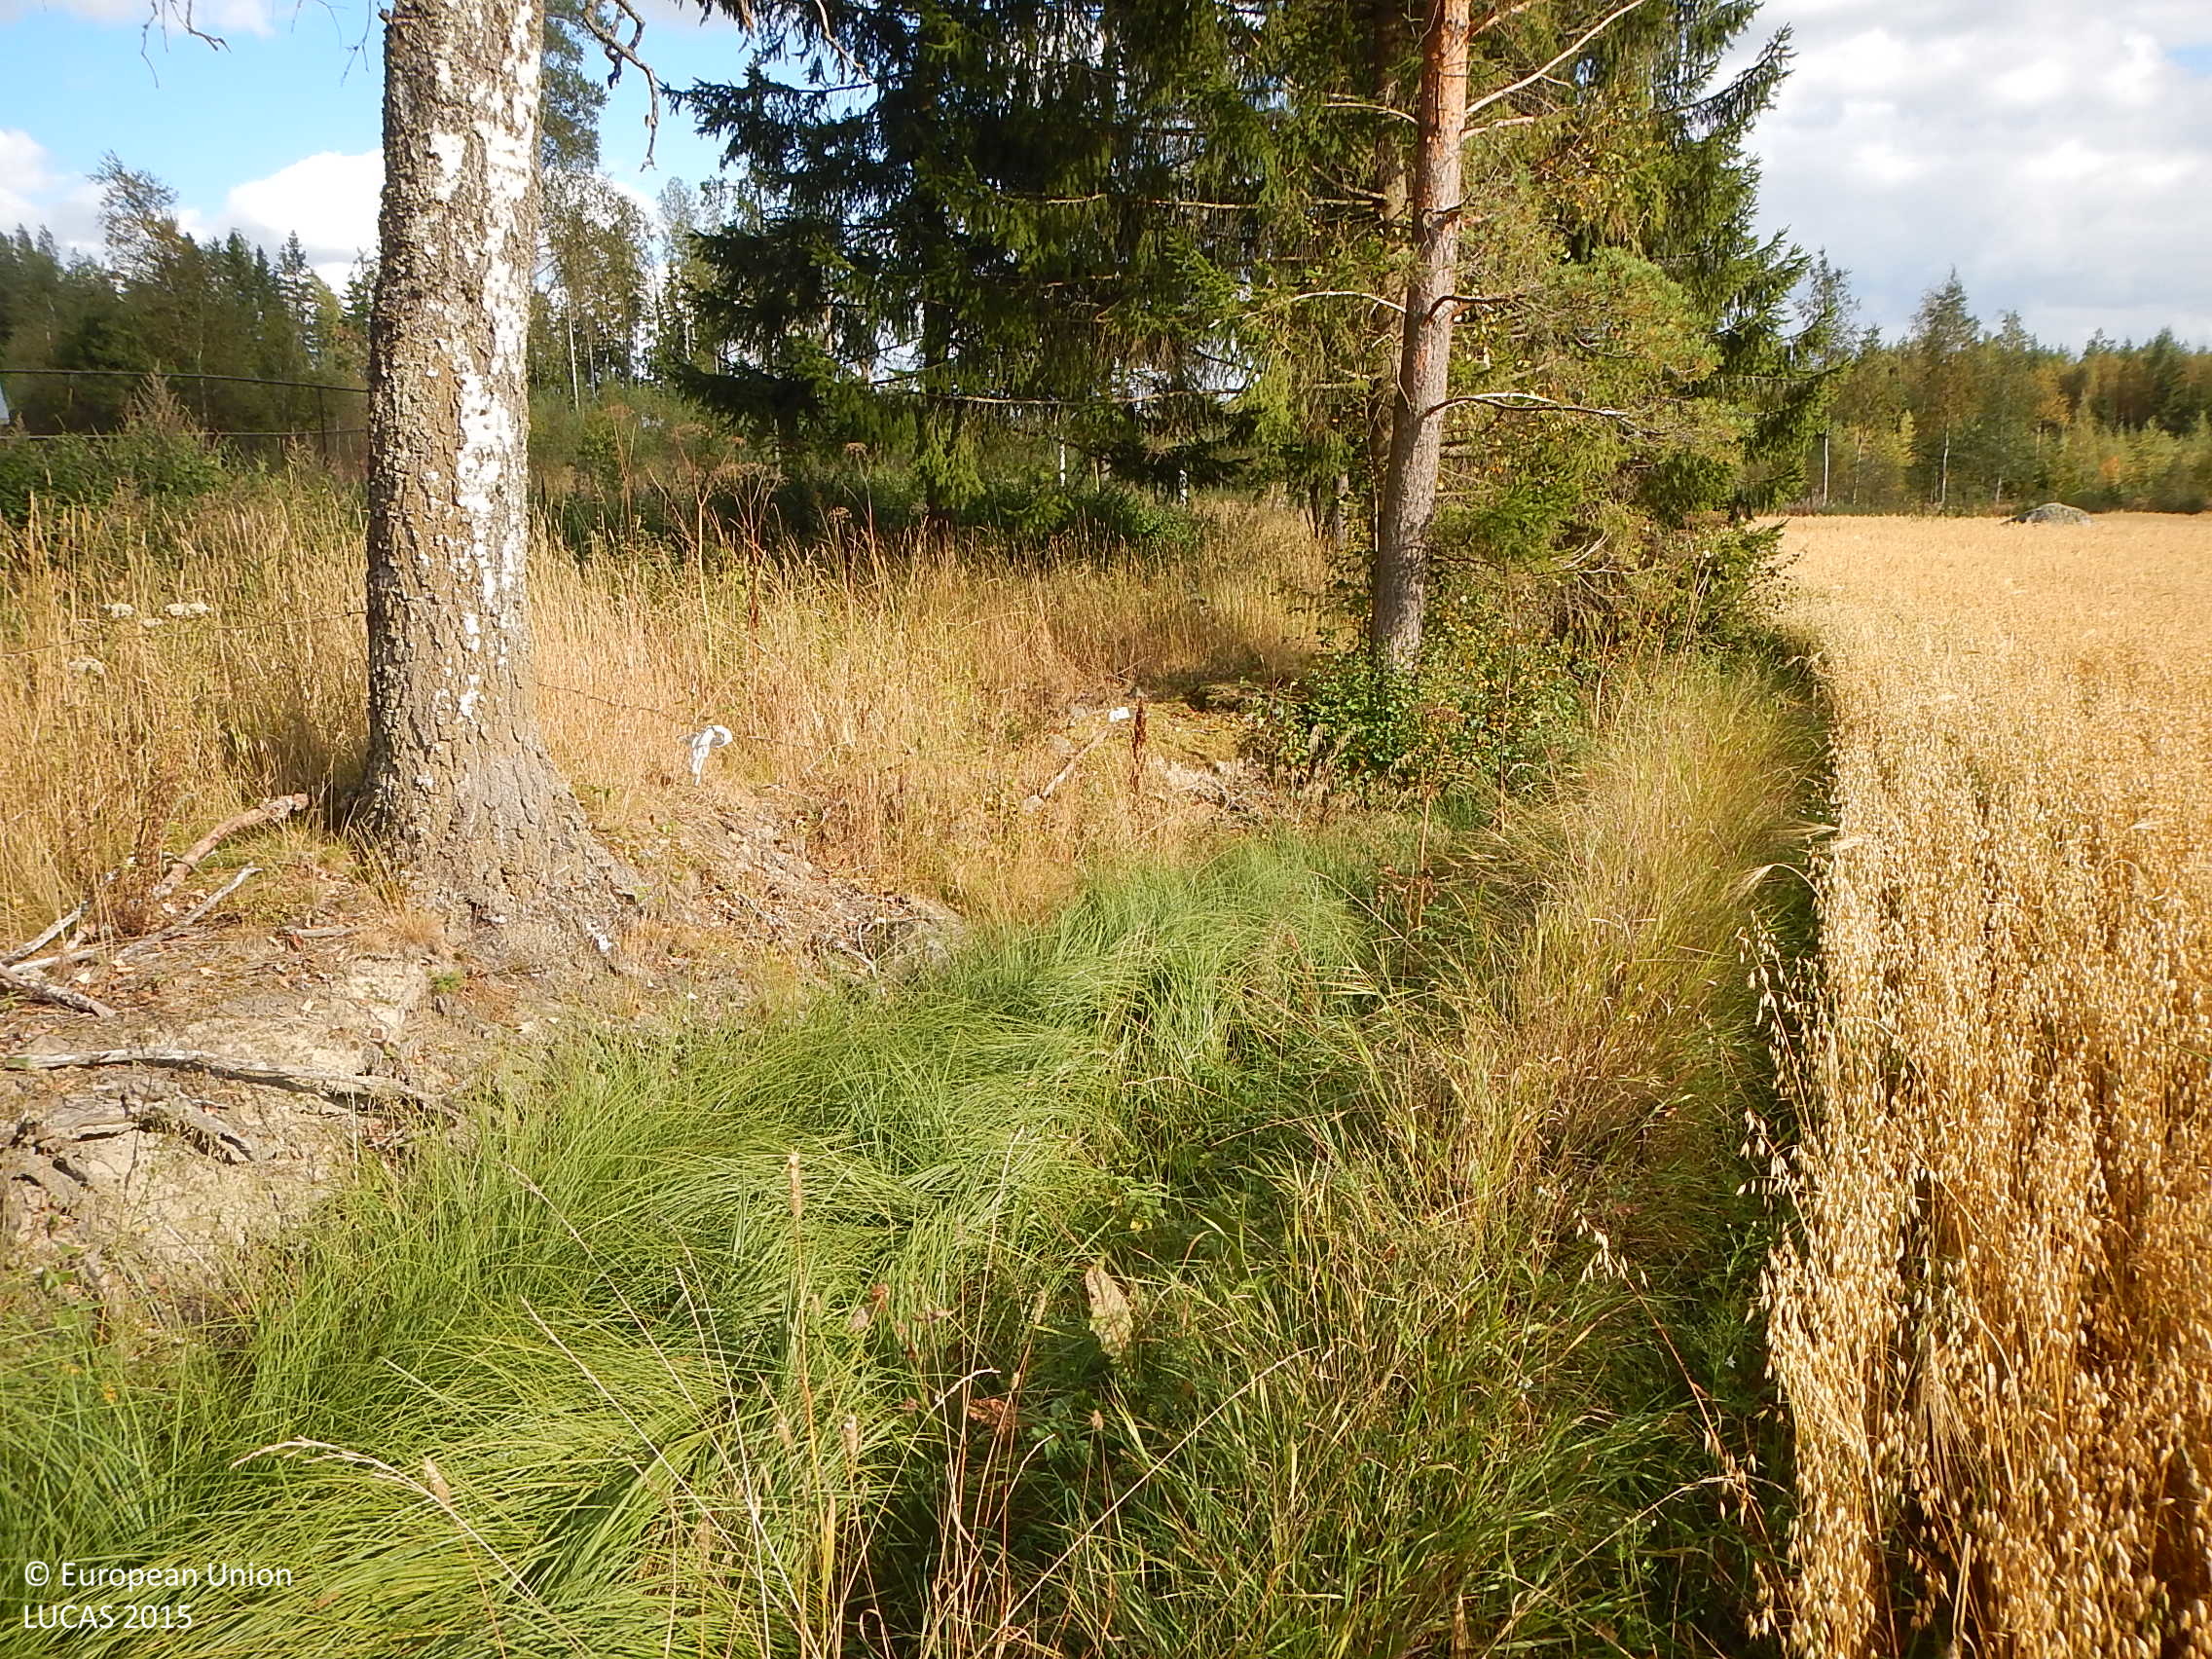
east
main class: Cropland
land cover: Oats
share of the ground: > 75 %
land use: Agriculture (excluding fallow land and kitchen gardens)
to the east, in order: Oats; Grass margins; Ditches and canals; Spruce dominated coniferous woodland; Grassland with sparse tree/shrub cover; Oats; Ditches and canals; Broadleaved woodland
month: September
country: FI
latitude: 61.5387
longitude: 22.3058
